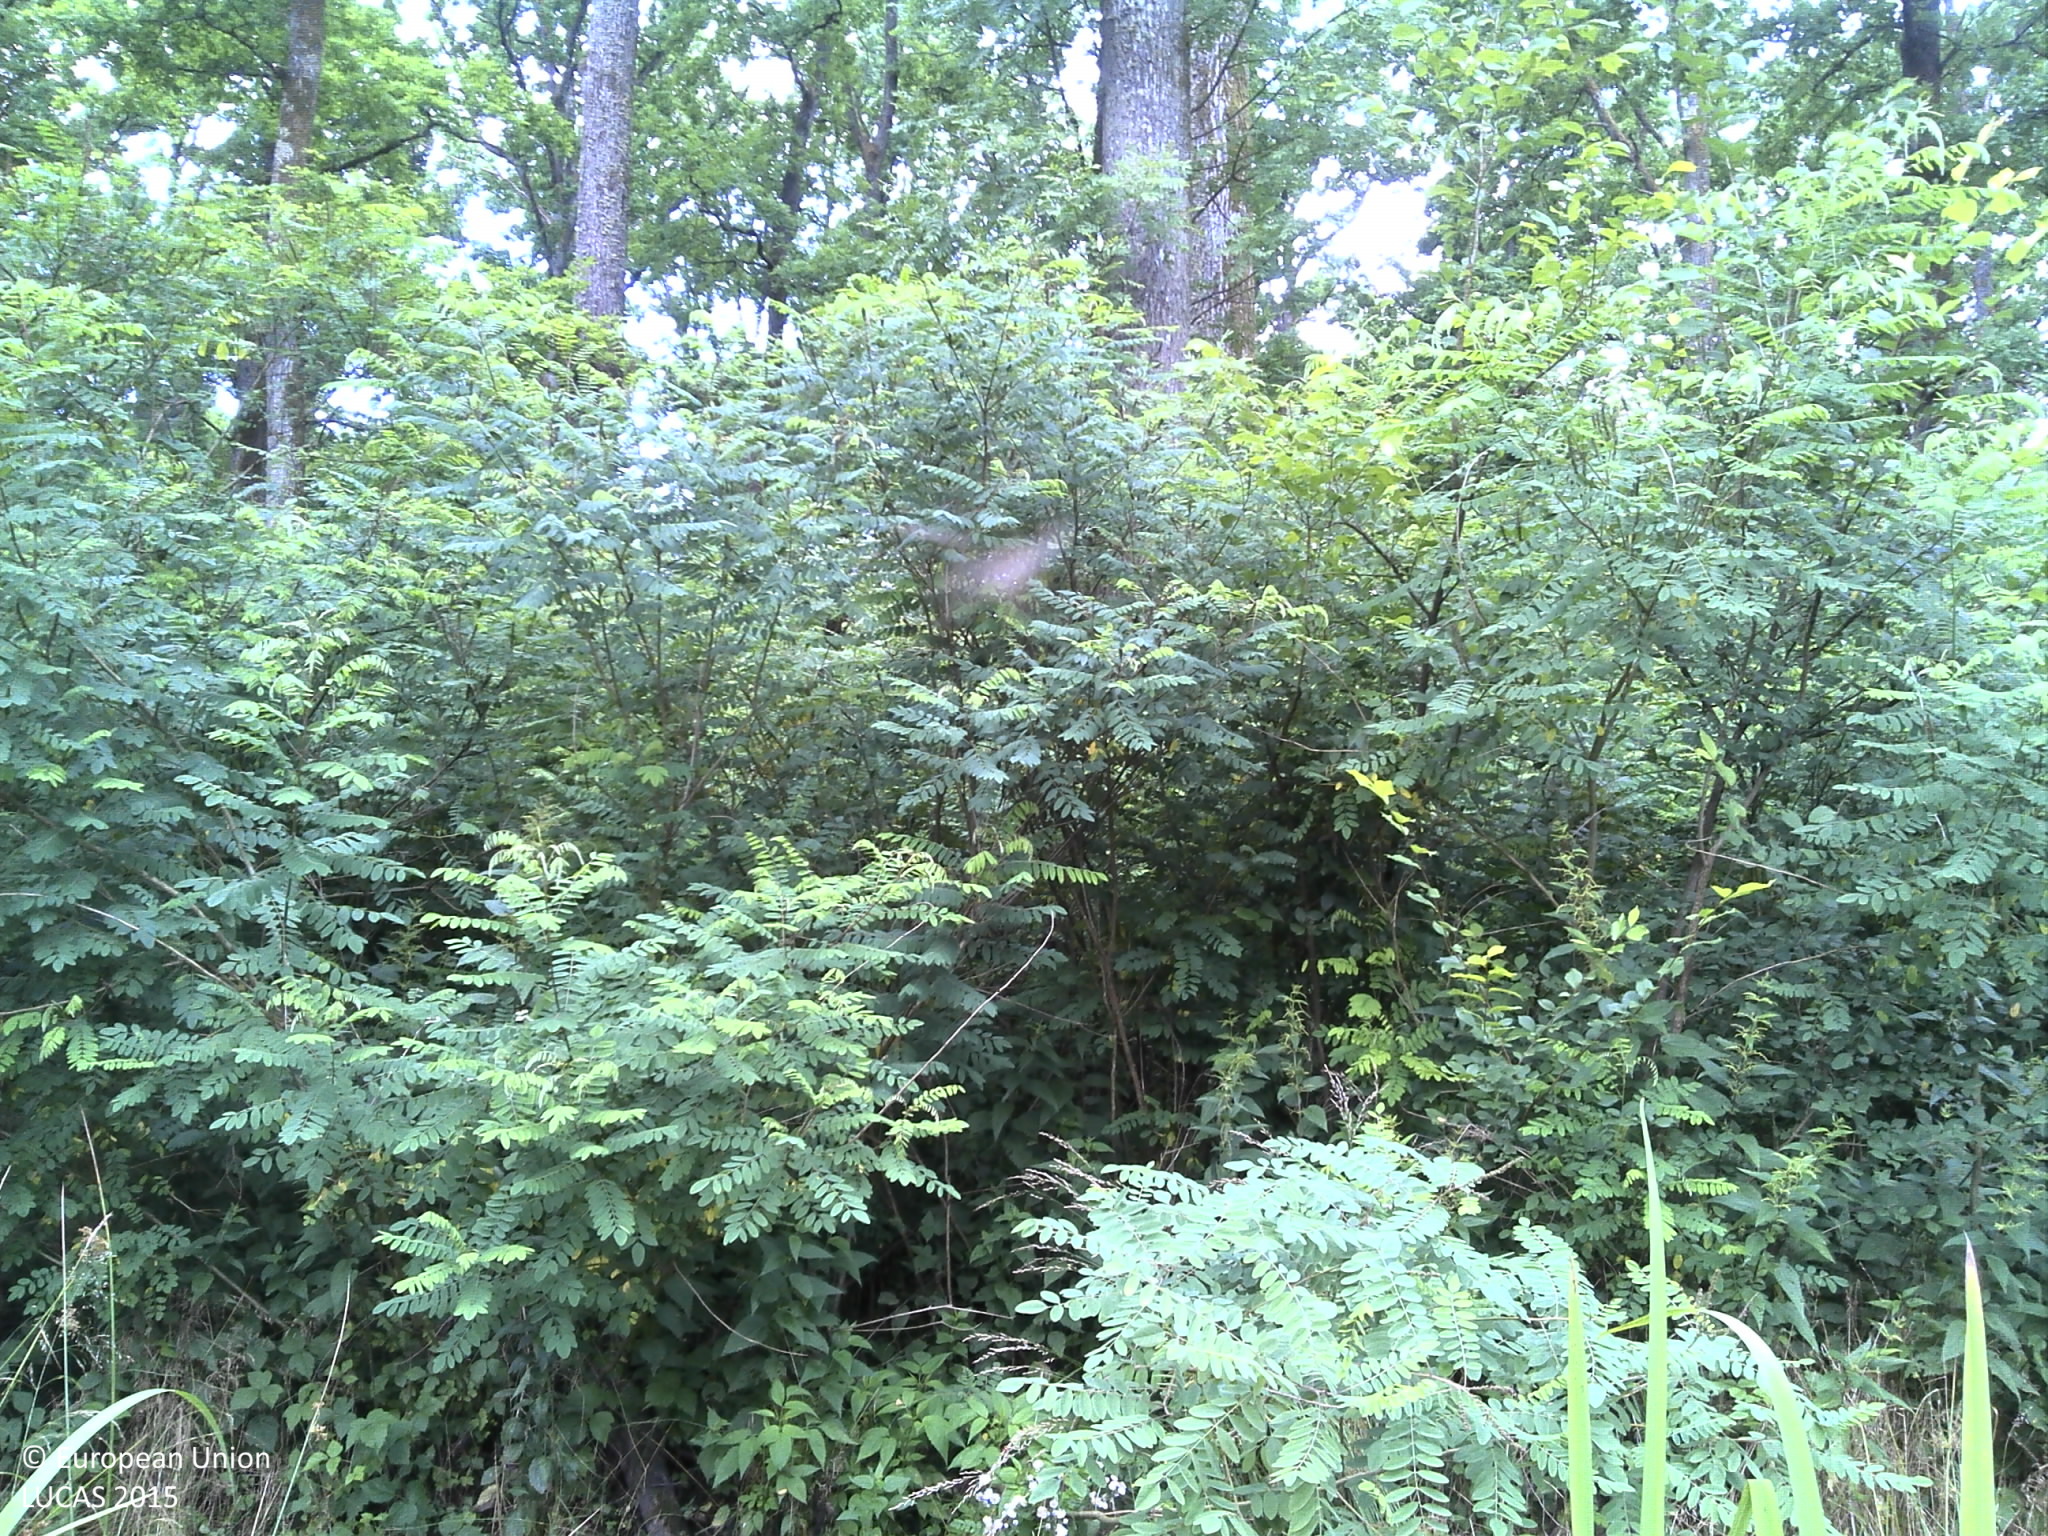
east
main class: Woodland
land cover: Broadleaved woodland
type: acidophilous oak and oak-birch forest
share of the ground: > 75 %
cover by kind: broadleaved forest trees 100 %
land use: Forestry
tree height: > 5 m
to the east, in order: Broadleaved woodland
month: June
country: HR
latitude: 45.1745
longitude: 17.3673
